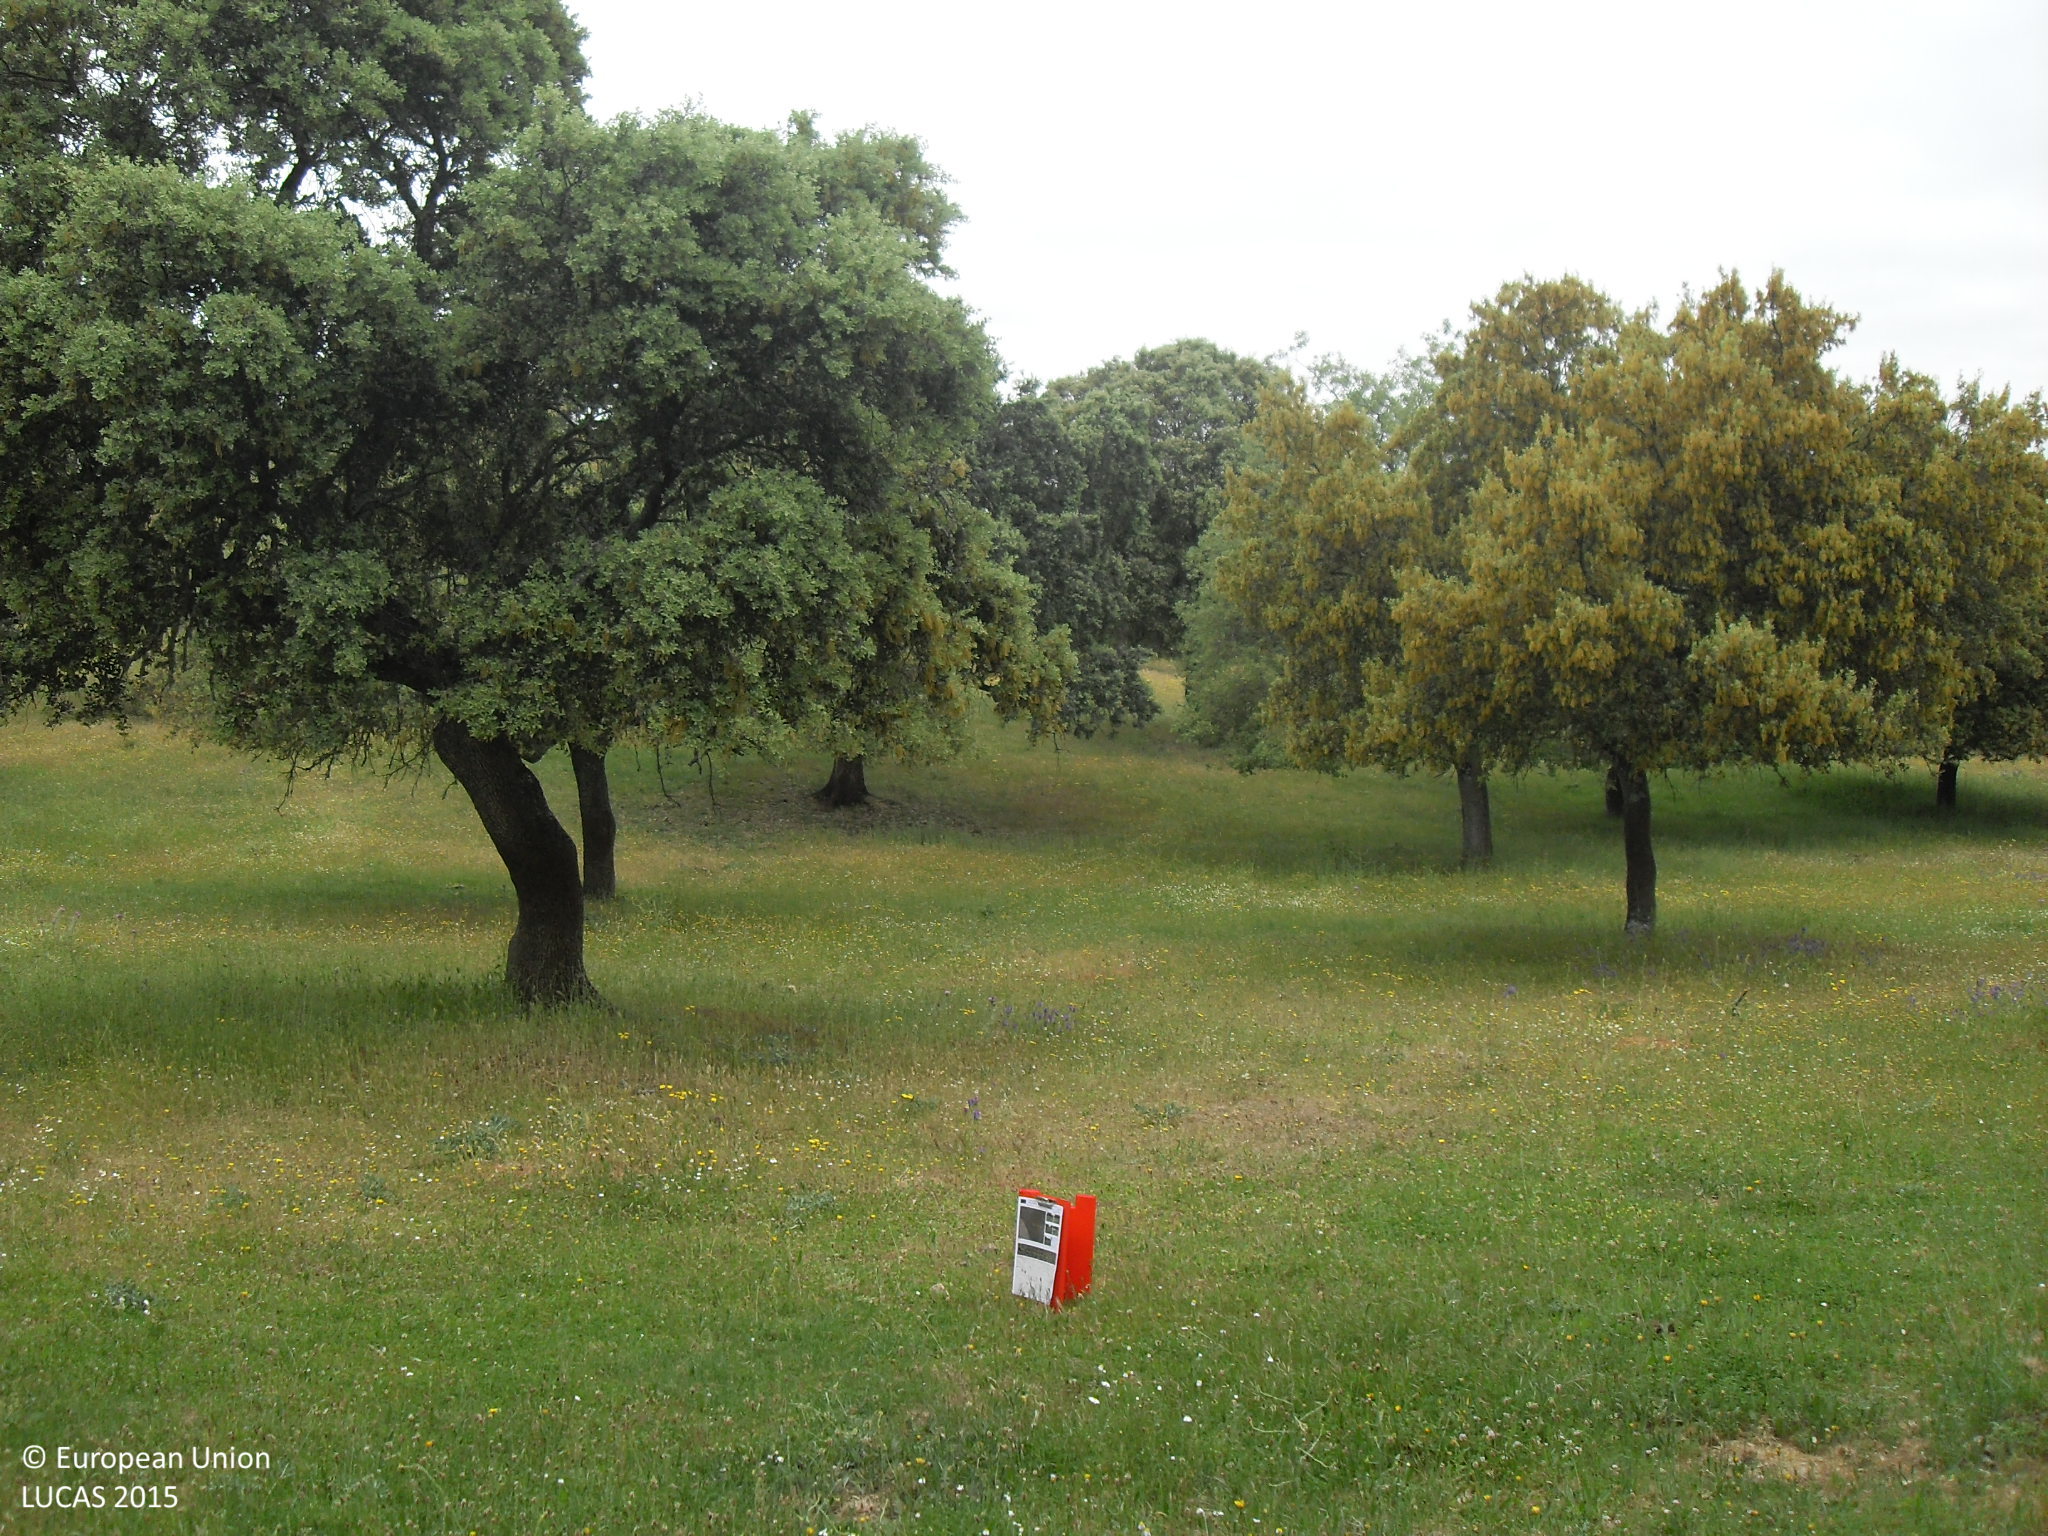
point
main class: Woodland
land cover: Broadleaved woodland
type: broadleaved evergreen forest
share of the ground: 25 - 50 %
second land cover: Grassland without tree/shrub cover
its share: 50 - 75 %
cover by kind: herbaceous plants 55 %, broadleaved forest trees 45 %
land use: Forestry
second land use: Agriculture (excluding fallow land and kitchen gardens)
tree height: > 5 m
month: May
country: ES
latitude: 40.7103
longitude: -5.6626
